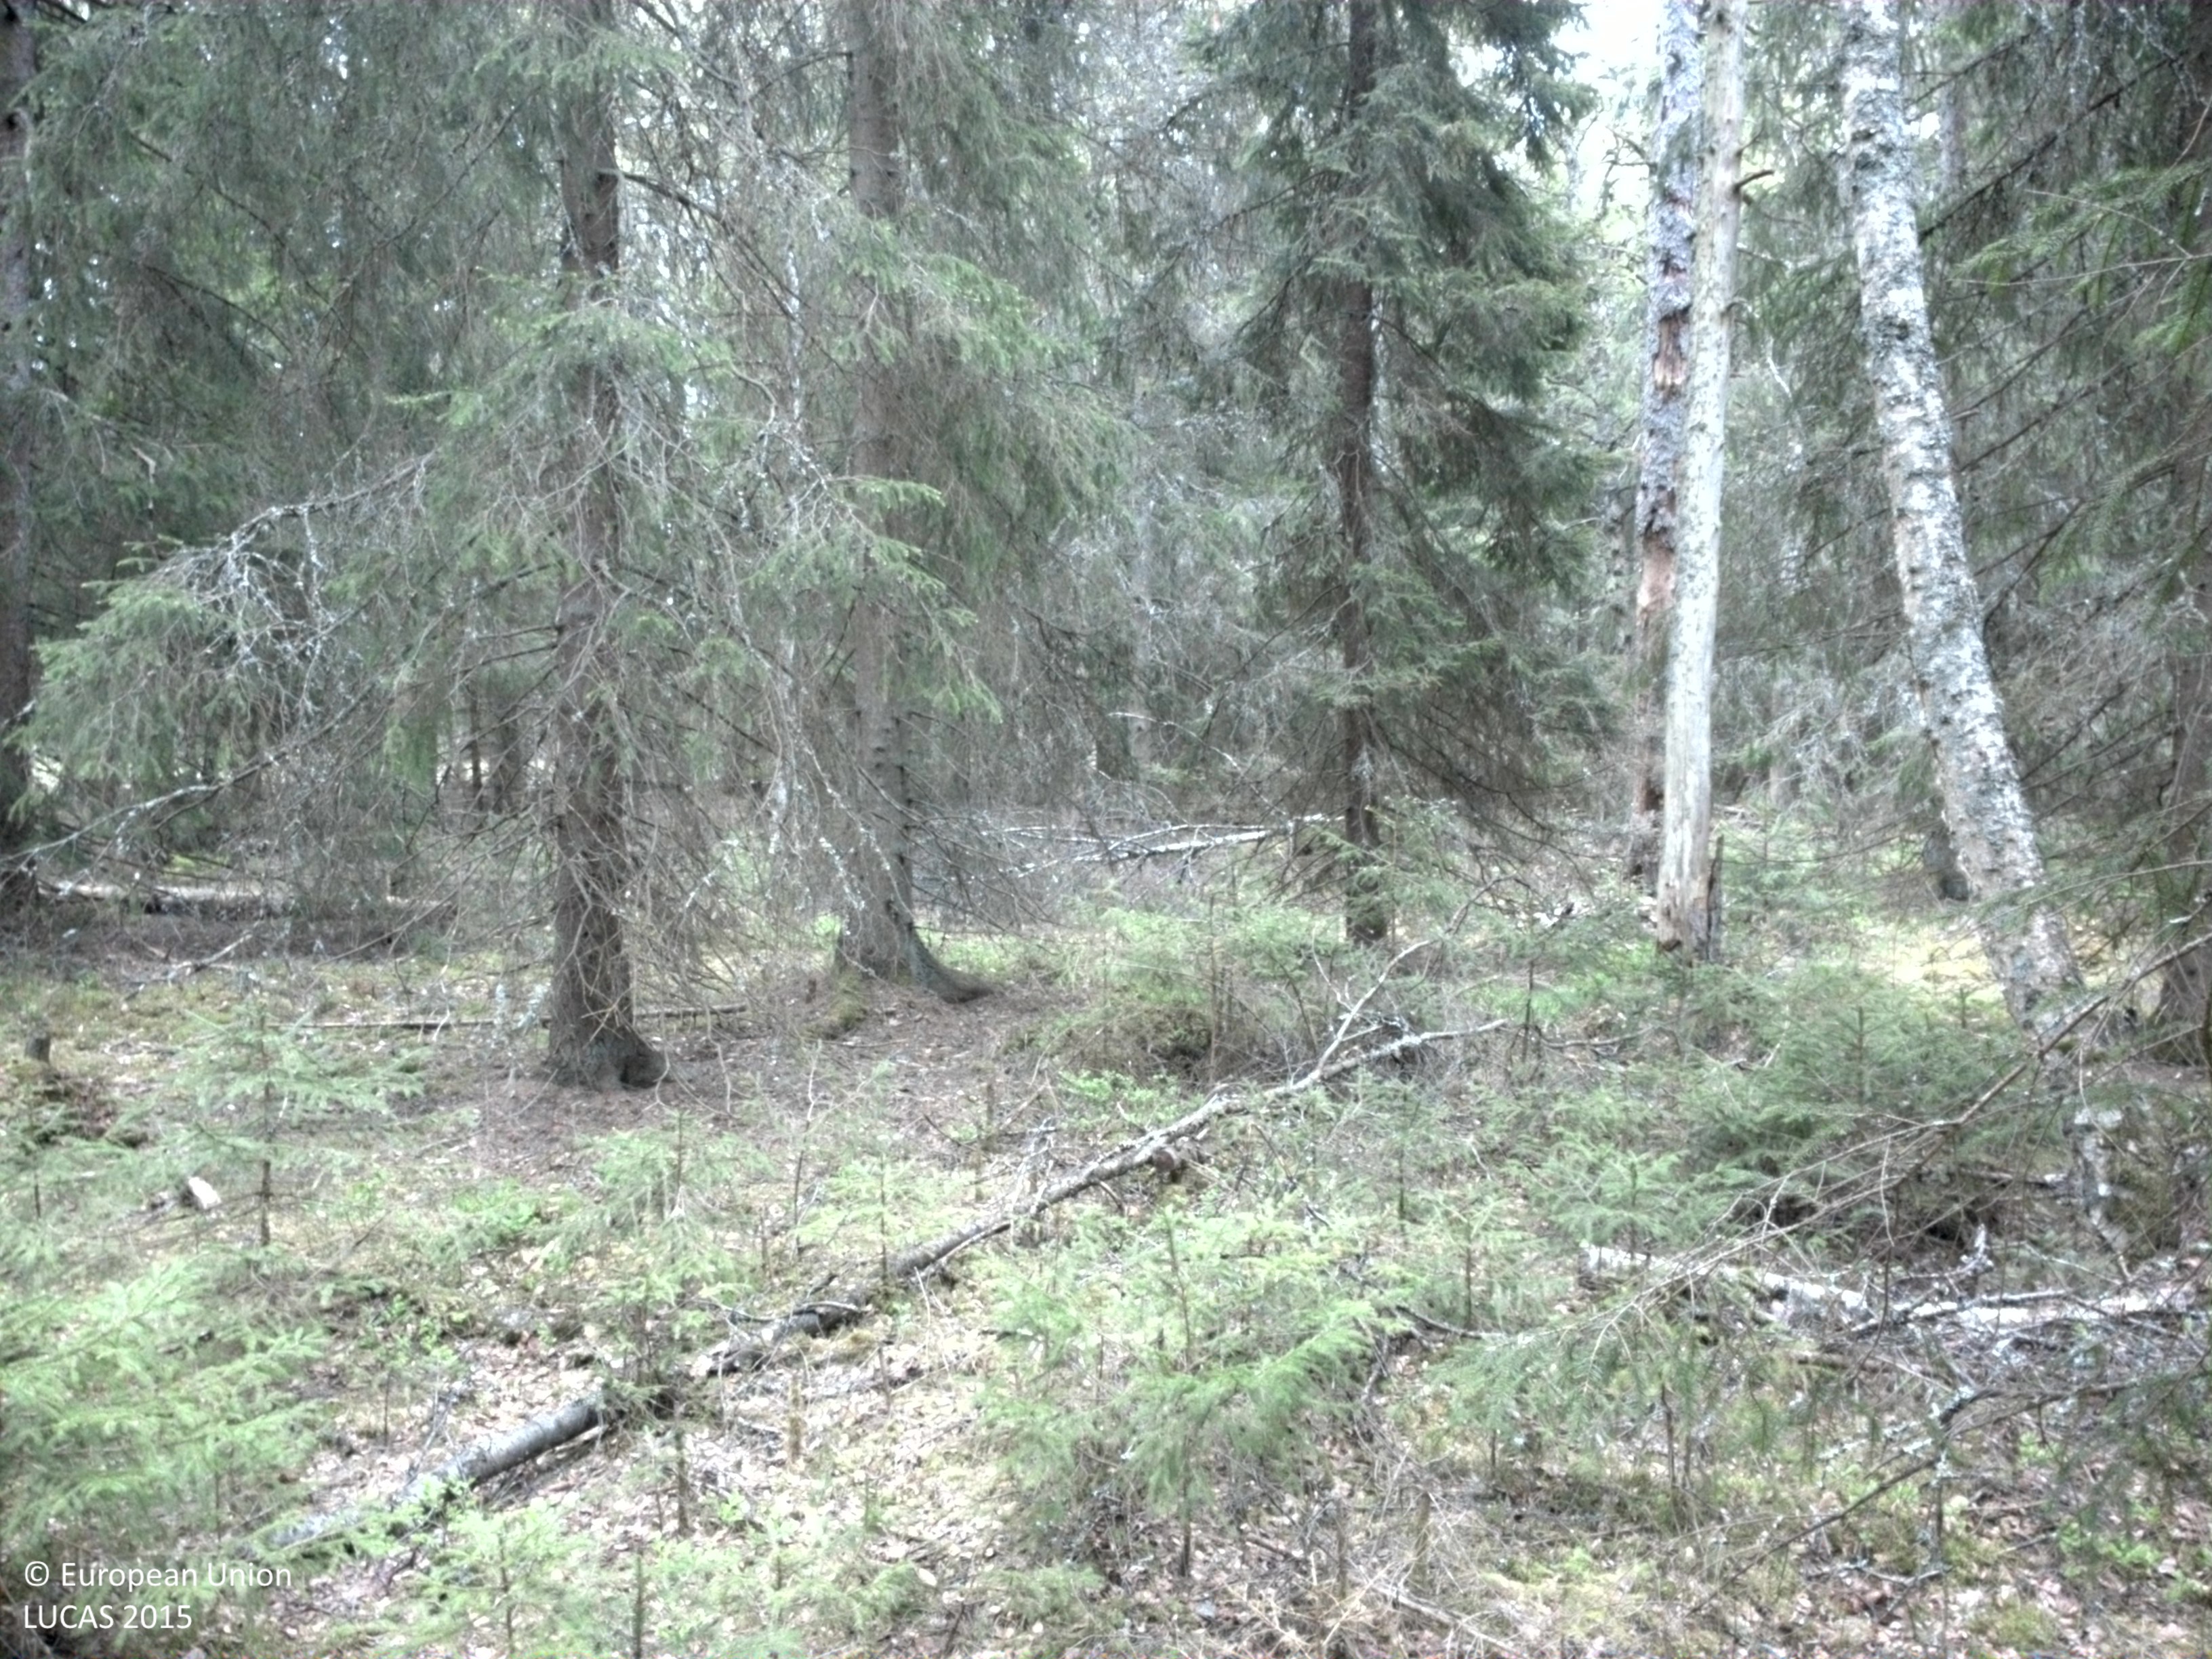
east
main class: Woodland
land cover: Spruce dominated coniferous woodland
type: boreal forest
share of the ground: 50 - 75 %
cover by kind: coniferous forest trees 60 %, shrubs 15 %, lichens and mosses 15 %, broadleaved forest trees 10 %
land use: Forestry
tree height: > 5 m
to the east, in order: Spruce dominated coniferous woodland; Ditches and canals; Broadleaved woodland; Grassland with sparse tree/shrub cover; Spruce dominated coniferous woodland; Pine dominated coniferous woodland
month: May
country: SE
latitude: 57.0047
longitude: 15.1178
